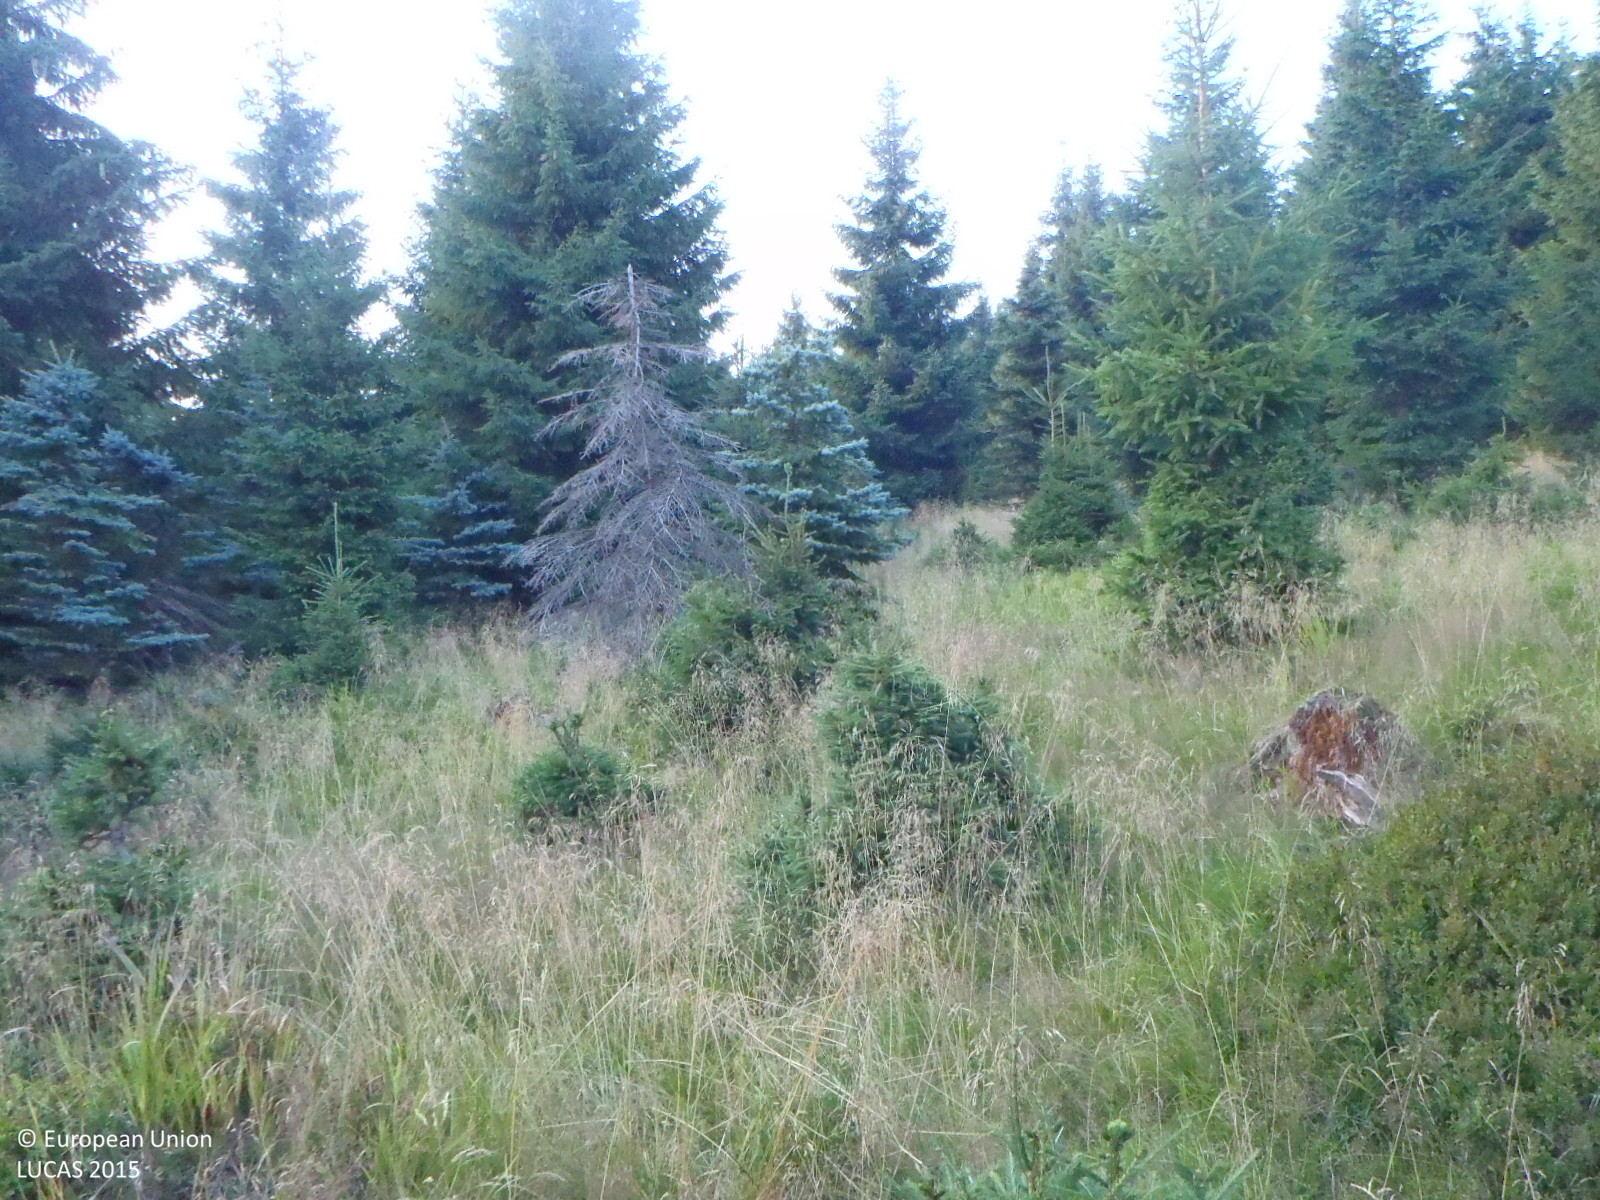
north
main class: Woodland
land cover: Spruce dominated coniferous woodland
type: hemiboreal forest and nemoral coniferous forest and mixed broadleaved-coniferous forest
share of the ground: > 75 %
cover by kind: coniferous forest trees 80 %, herbaceous plants 15 %, shrubs 5 %
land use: Forestry
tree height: > 5 m
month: August
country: CZ
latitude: 50.8205
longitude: 15.2414
